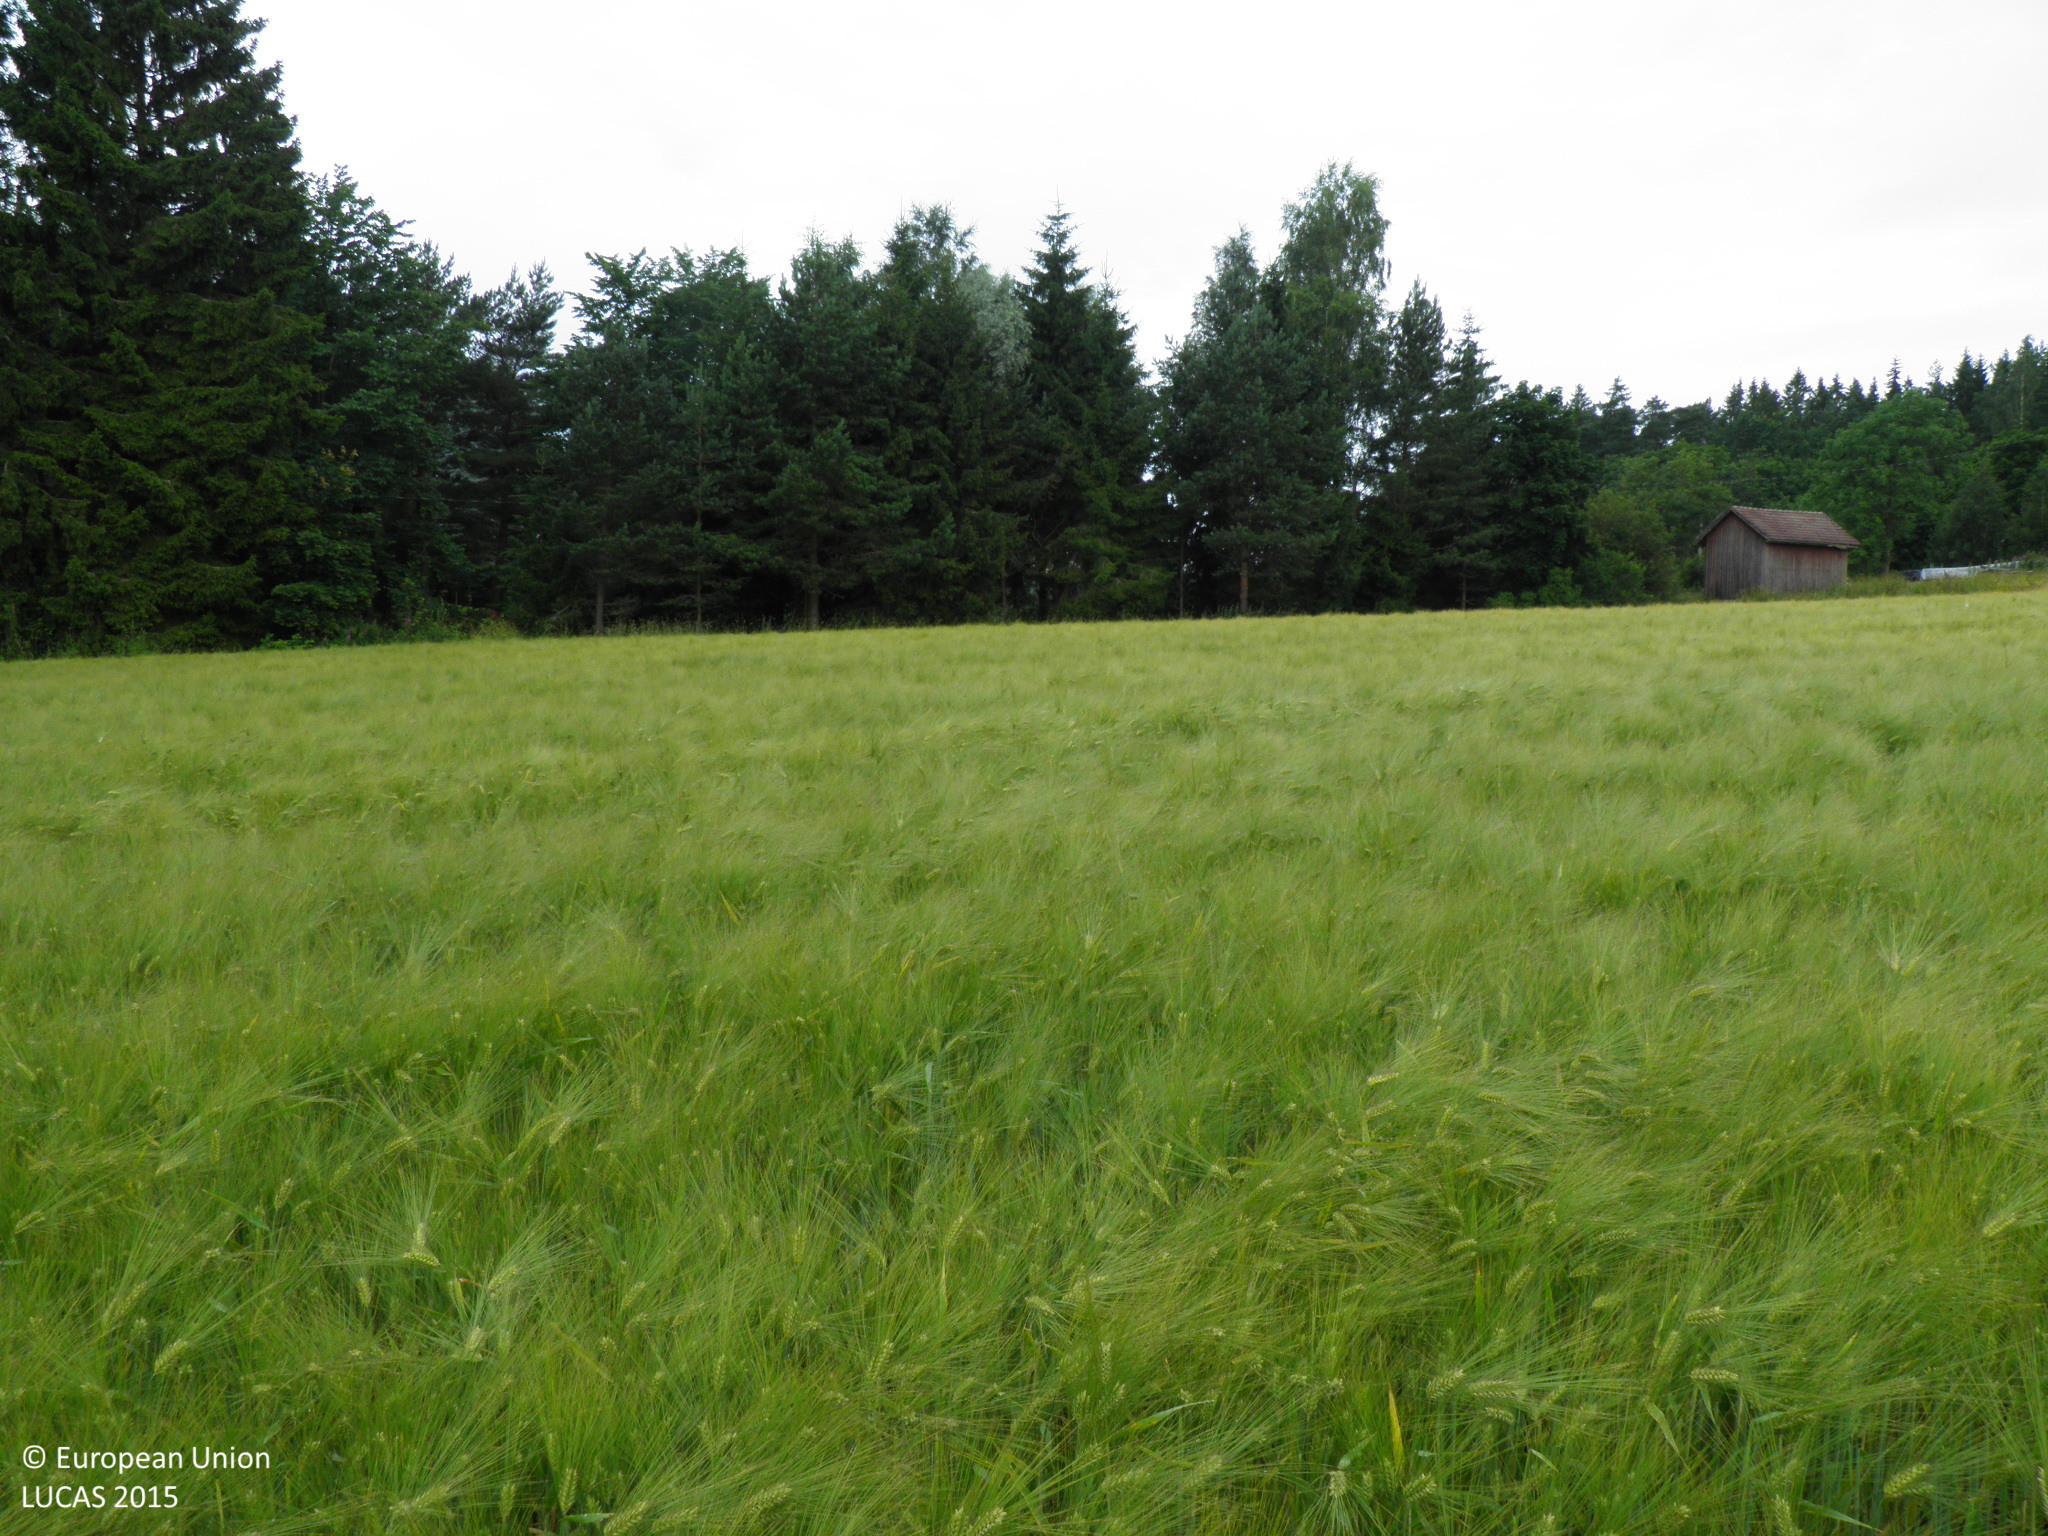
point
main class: Cropland
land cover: Barley
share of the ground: > 75 %
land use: Agriculture (excluding fallow land and kitchen gardens)
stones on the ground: < 10 %
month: July
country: FI
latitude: 60.1483
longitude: 22.7377
